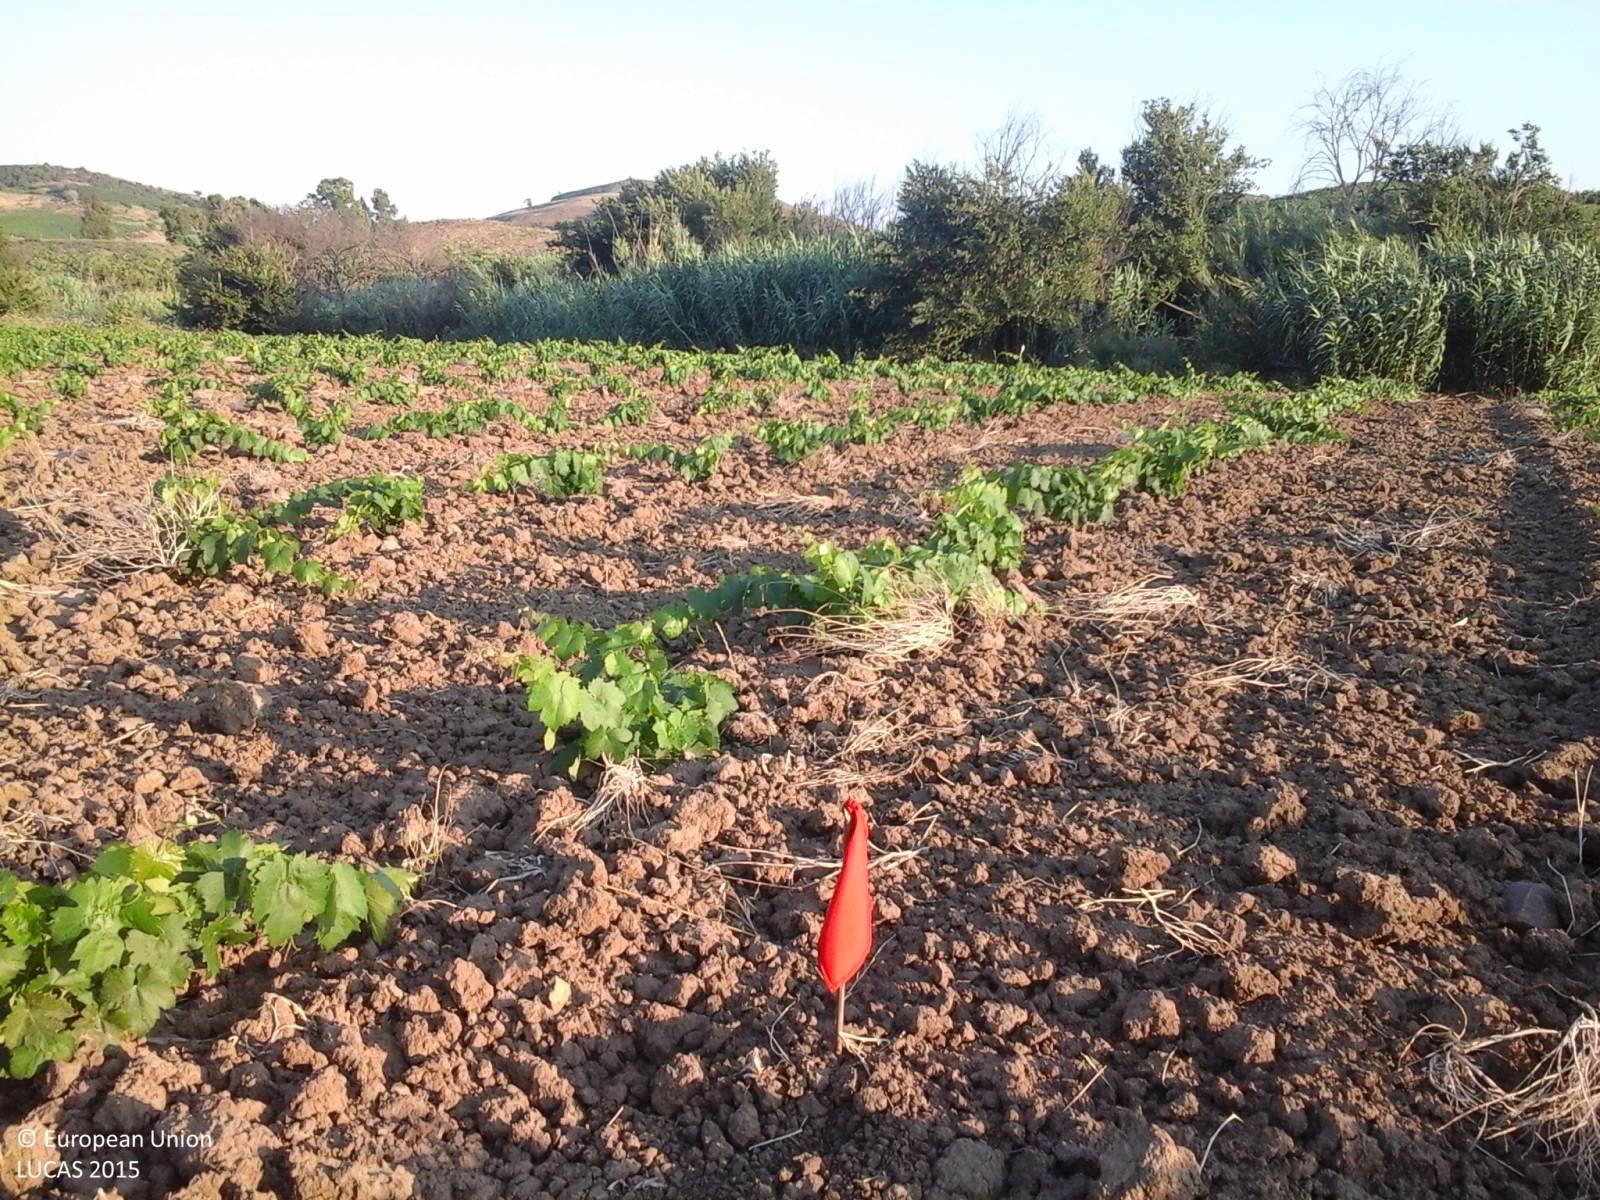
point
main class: Cropland
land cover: Vineyards
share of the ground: < 10 %
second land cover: Other bare soil
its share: > 75 %
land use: Agriculture (excluding fallow land and kitchen gardens)
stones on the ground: < 10 %
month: July
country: IT
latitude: 37.9017
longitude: 12.9468
